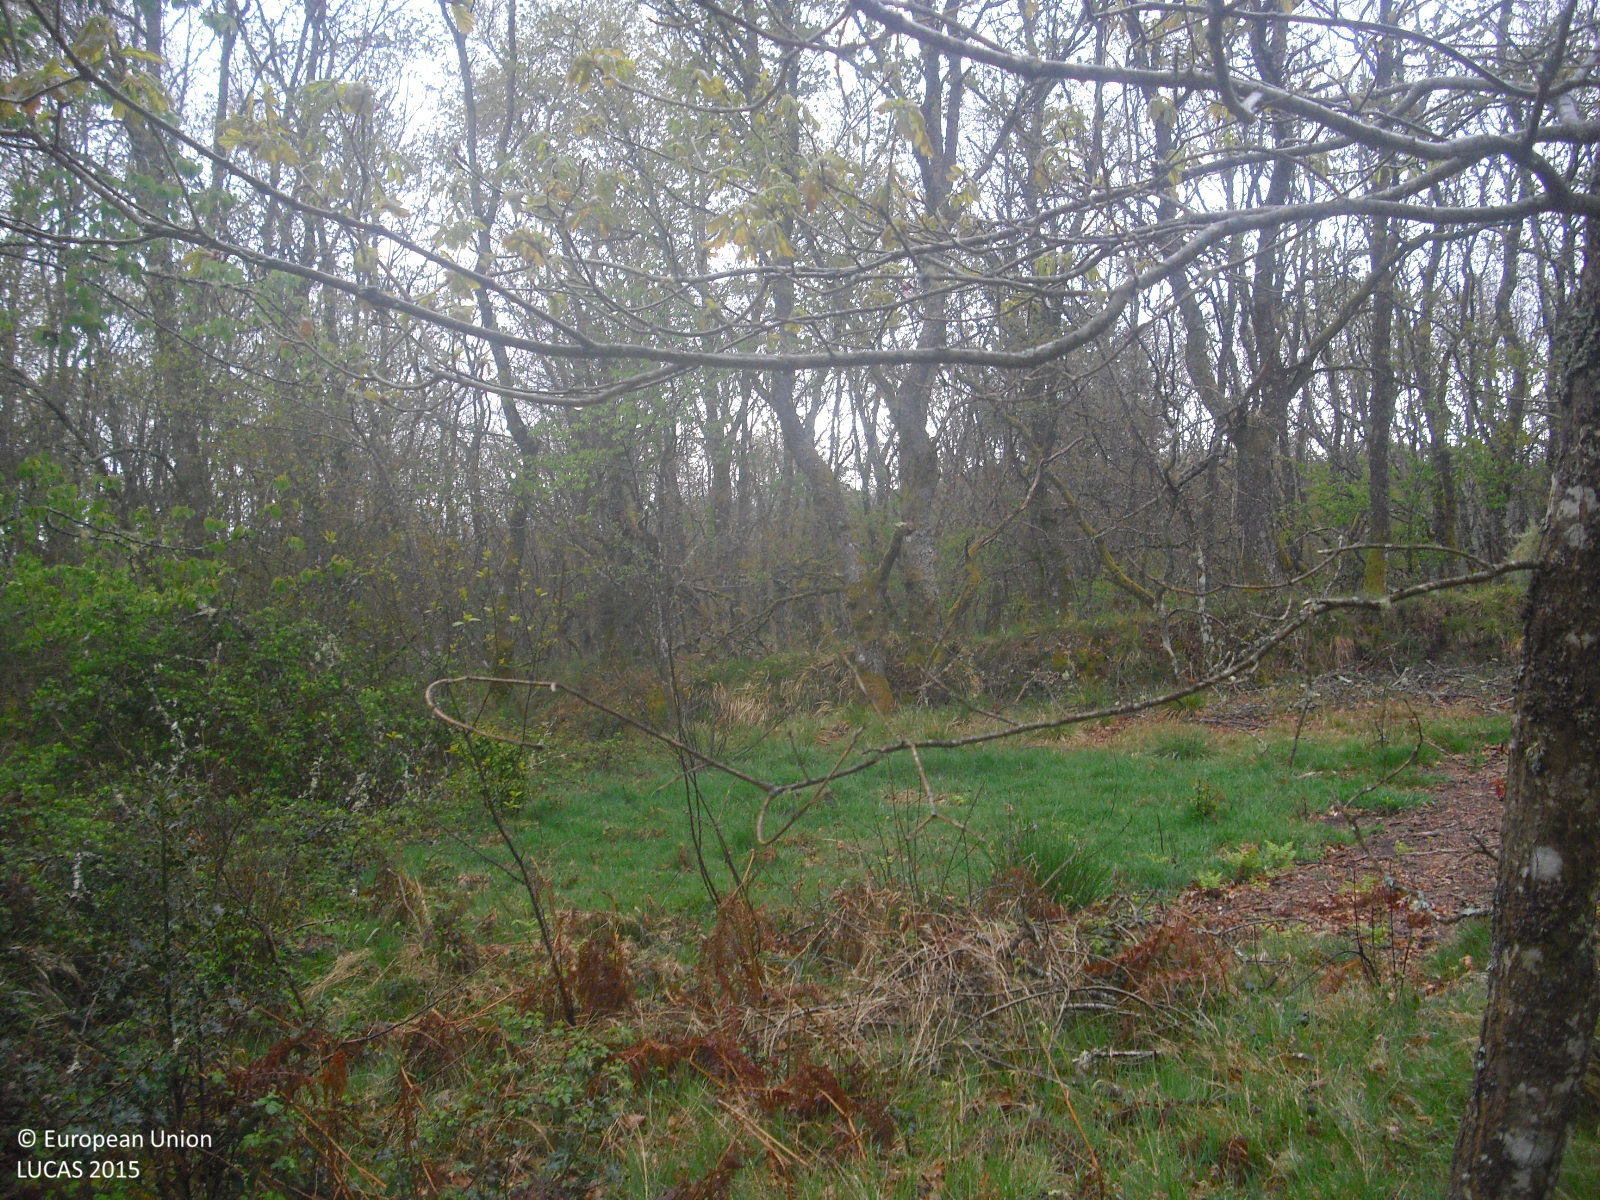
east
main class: Woodland
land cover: Broadleaved woodland
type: thermophilous deciduous forest
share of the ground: > 75 %
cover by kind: broadleaved forest trees 70 %, herbaceous plants 20 %, shrubs 10 %
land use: Forestry
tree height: > 5 m
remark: Clear cut
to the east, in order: Broadleaved woodland; Grassland with sparse tree/shrub cover; Ditches and canals; Broadleaved woodland; Tracks; Broadleaved woodland; Shrubland without tree cover; Broadleaved woodland; Tracks; Dry stone walls; Single bushes/trees; Grassland without tree/shrub cover; Ditches and canals; Grassland without tree/shrub cover; Ditches and canals; Grassland without tree/shrub cover; Abandoned hedges; Ditches and canals; Grassland without tree/shrub cover; Single bushes/trees; Grassland without tree/shrub cover; Abandoned hedges; Shruby margins; Spontaneously vegetated surfaces
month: April
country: ES
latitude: 42.0768
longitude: -7.9034
